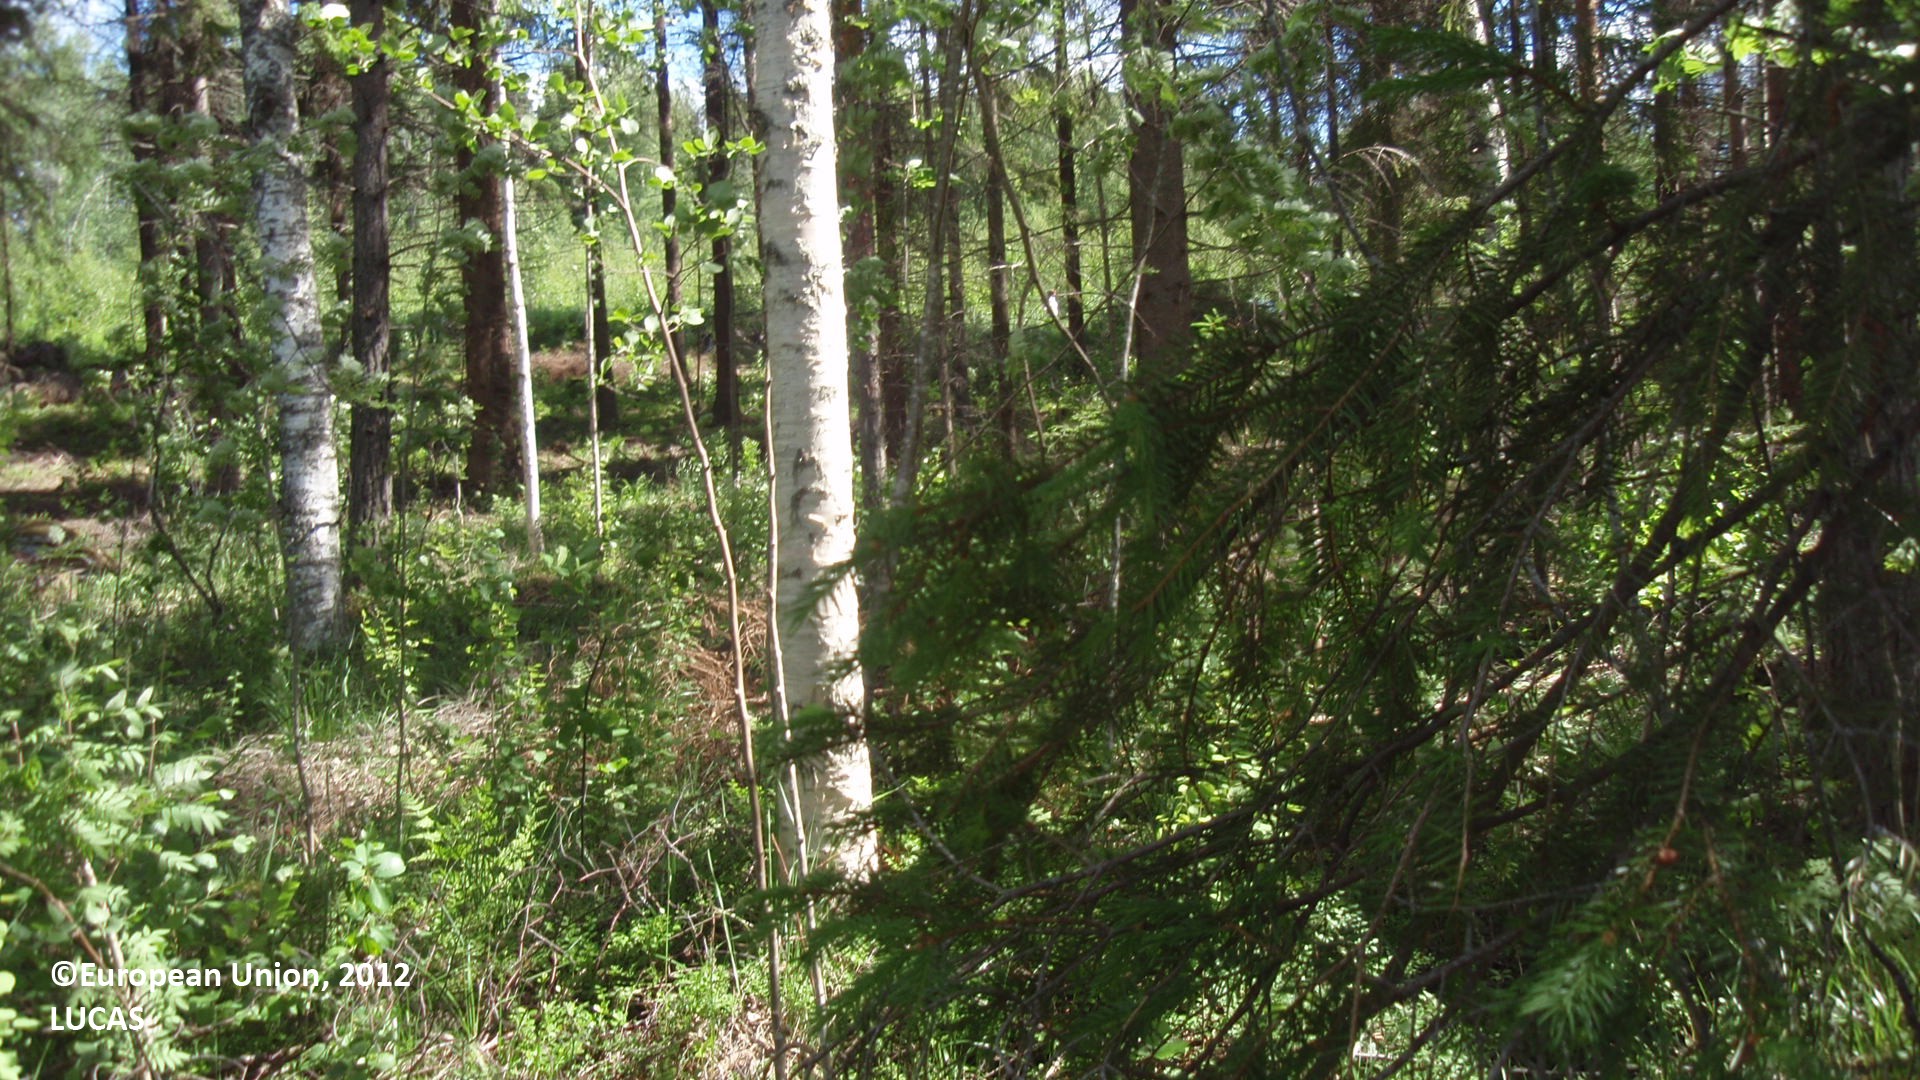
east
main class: Woodland
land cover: Spruce dominated mixed woodland
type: boreal forest
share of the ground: 50 - 75 %
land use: Forestry
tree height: > 5 m
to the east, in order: Spruce dominated mixed woodland; Grass margins; Paved roads, cycling and walking lanes; Grass margins; Ditches and canals; Broadleaved woodland; Spruce dominated mixed woodland; Broadleaved woodland; Grass margins; Other bare soil
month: June
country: FI
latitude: 61.5974
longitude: 26.6792
